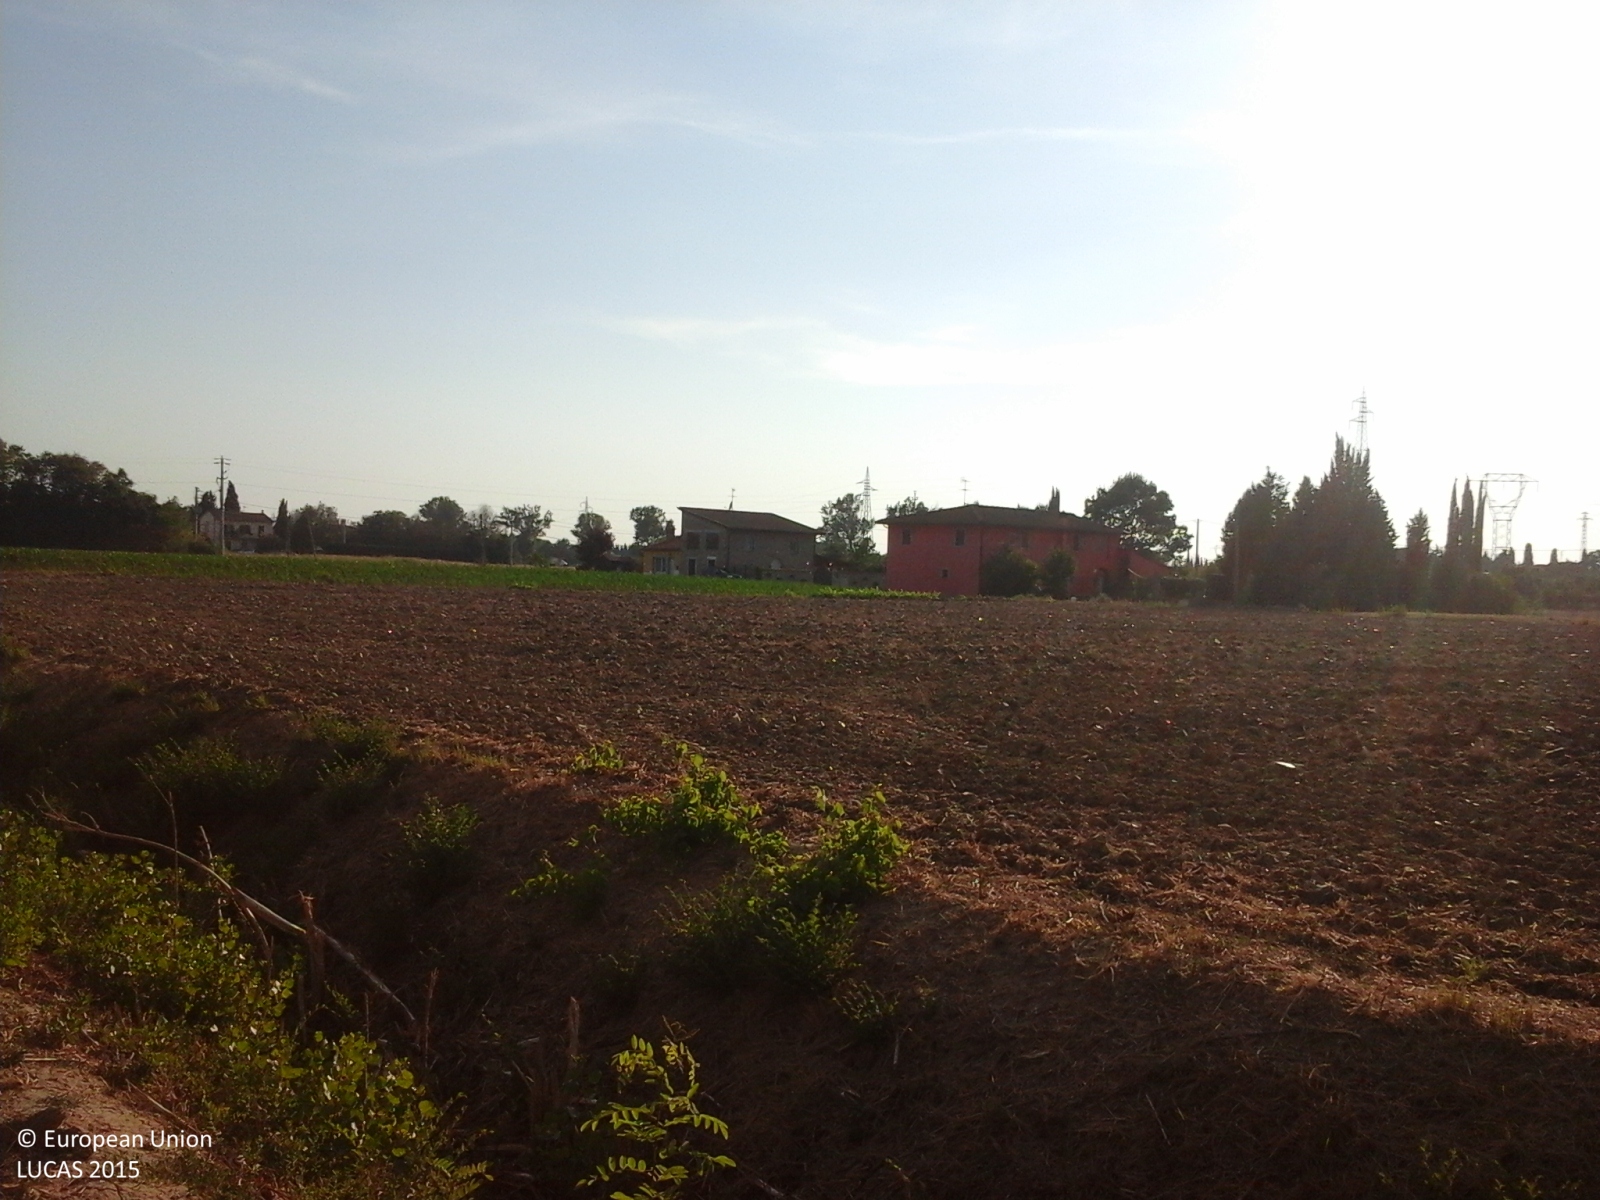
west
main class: Cropland
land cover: Maize
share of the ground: > 75 %
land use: Agriculture (excluding fallow land and kitchen gardens)
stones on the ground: < 10 %
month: July
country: IT
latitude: 43.7145
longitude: 10.9779
